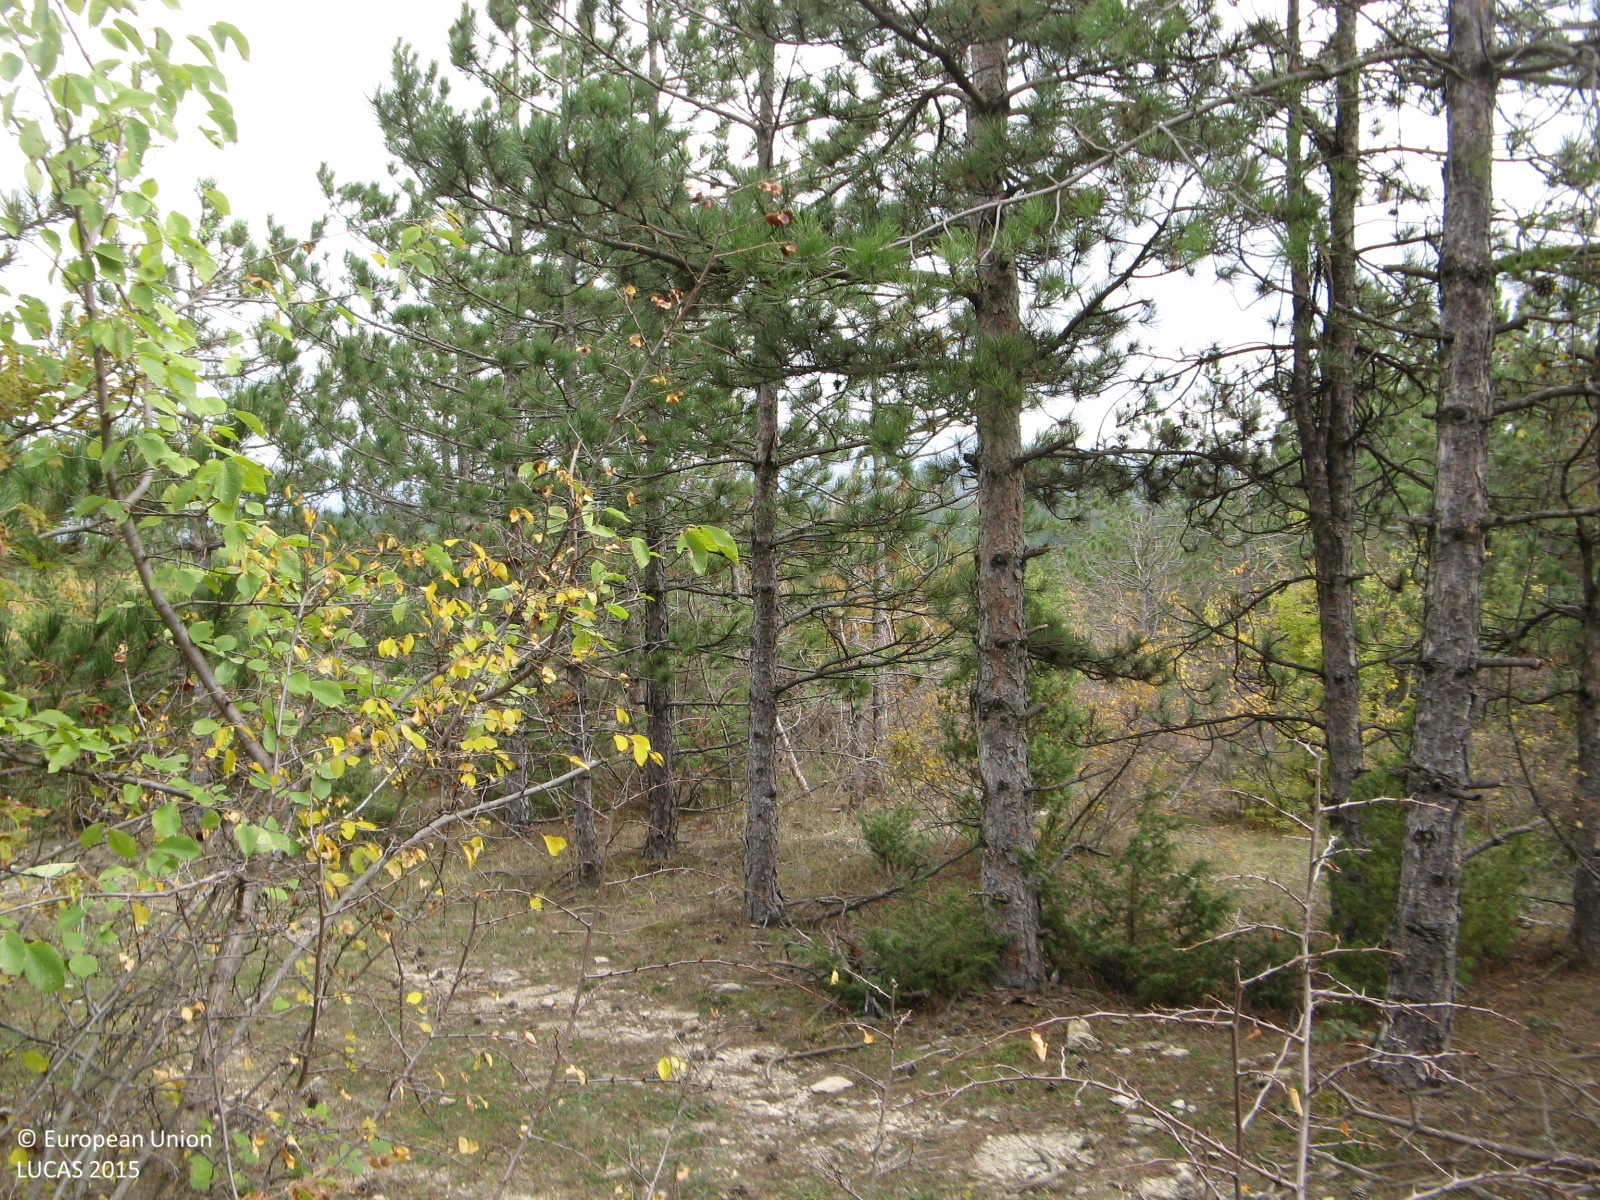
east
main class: Woodland
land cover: Pine dominated mixed woodland
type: hemiboreal forest and nemoral coniferous forest and mixed broadleaved-coniferous forest
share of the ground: > 75 %
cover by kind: coniferous forest trees 75 %, broadleaved forest trees 25 %
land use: Forestry
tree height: > 5 m
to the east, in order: Pine dominated mixed woodland; Tracks; Pine dominated mixed woodland; Rocks and stones; Pine dominated mixed woodland
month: November
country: BG
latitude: 41.4697
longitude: 25.2716
